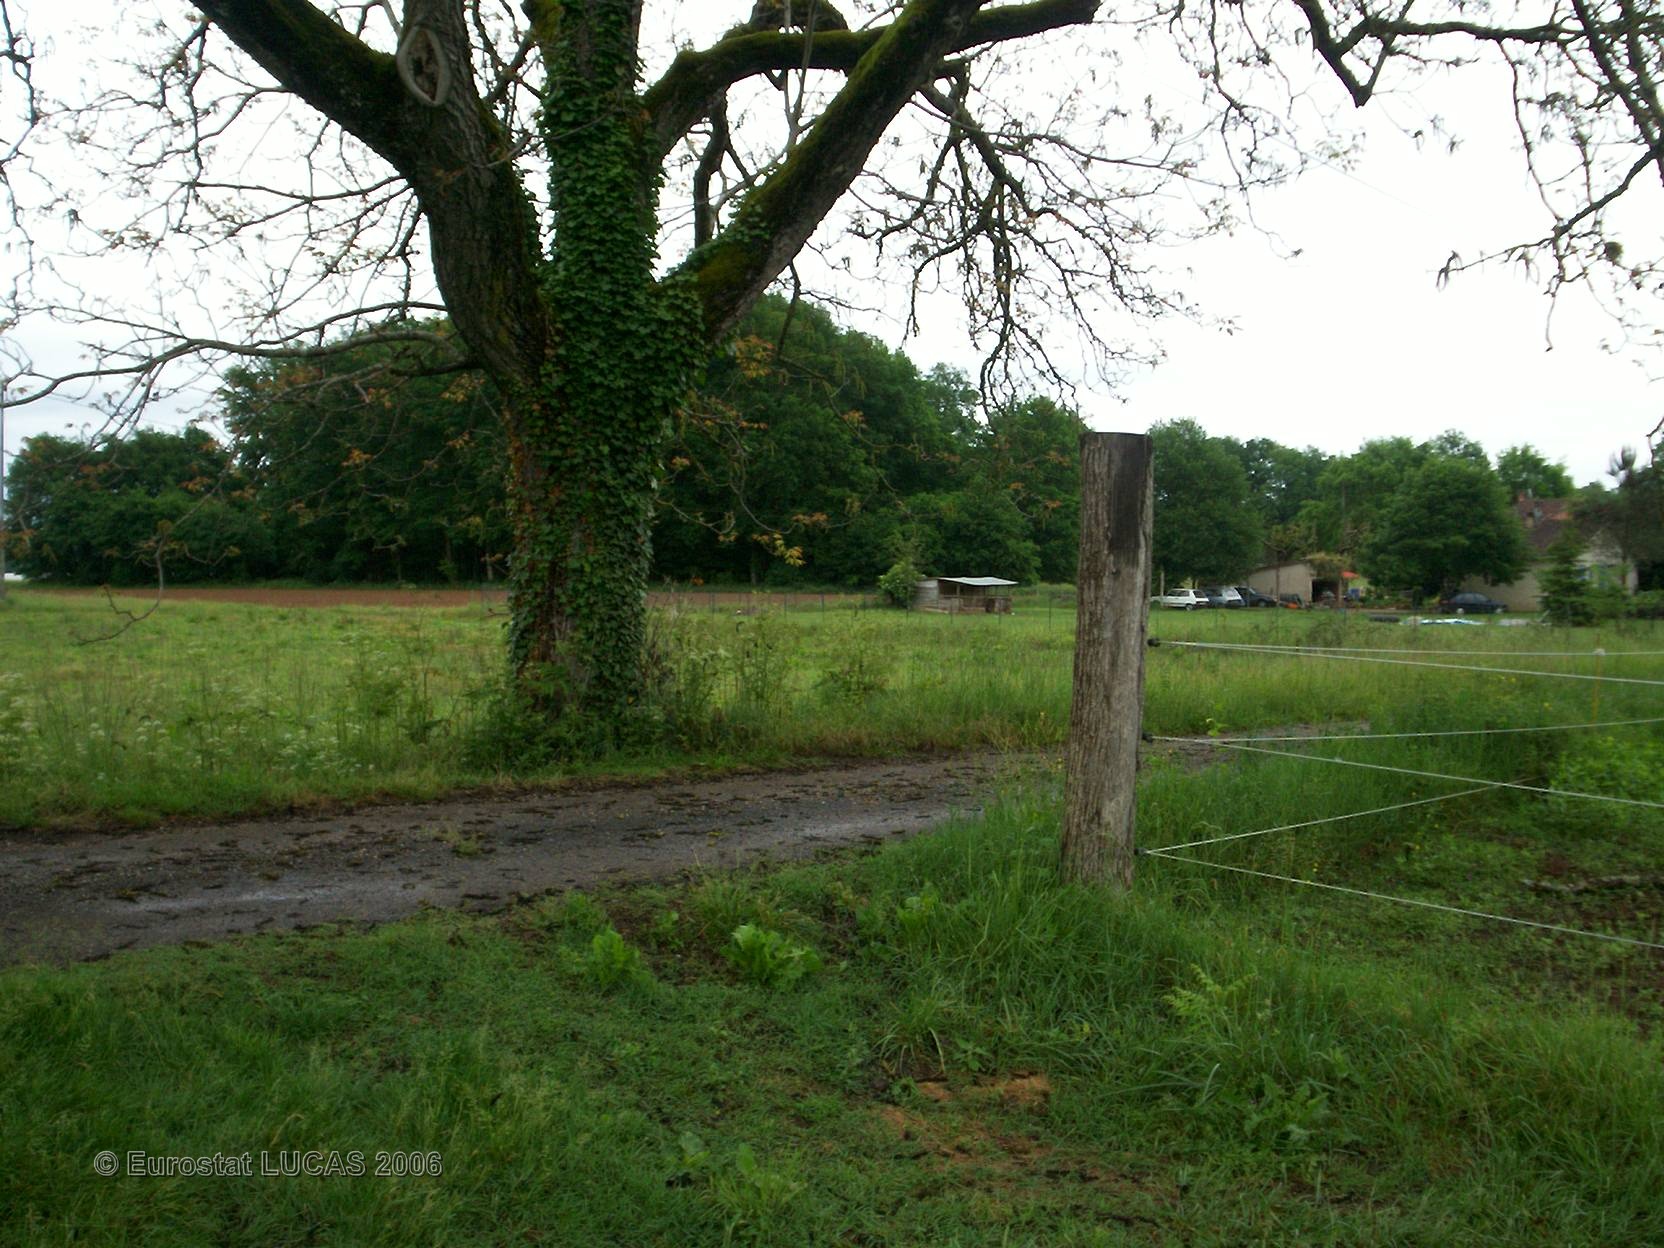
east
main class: Grassland
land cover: Grassland without tree/shrub cover
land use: Agriculture (excluding fallow land and kitchen gardens)
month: May
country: FR
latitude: 44.7876
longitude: 1.3635
